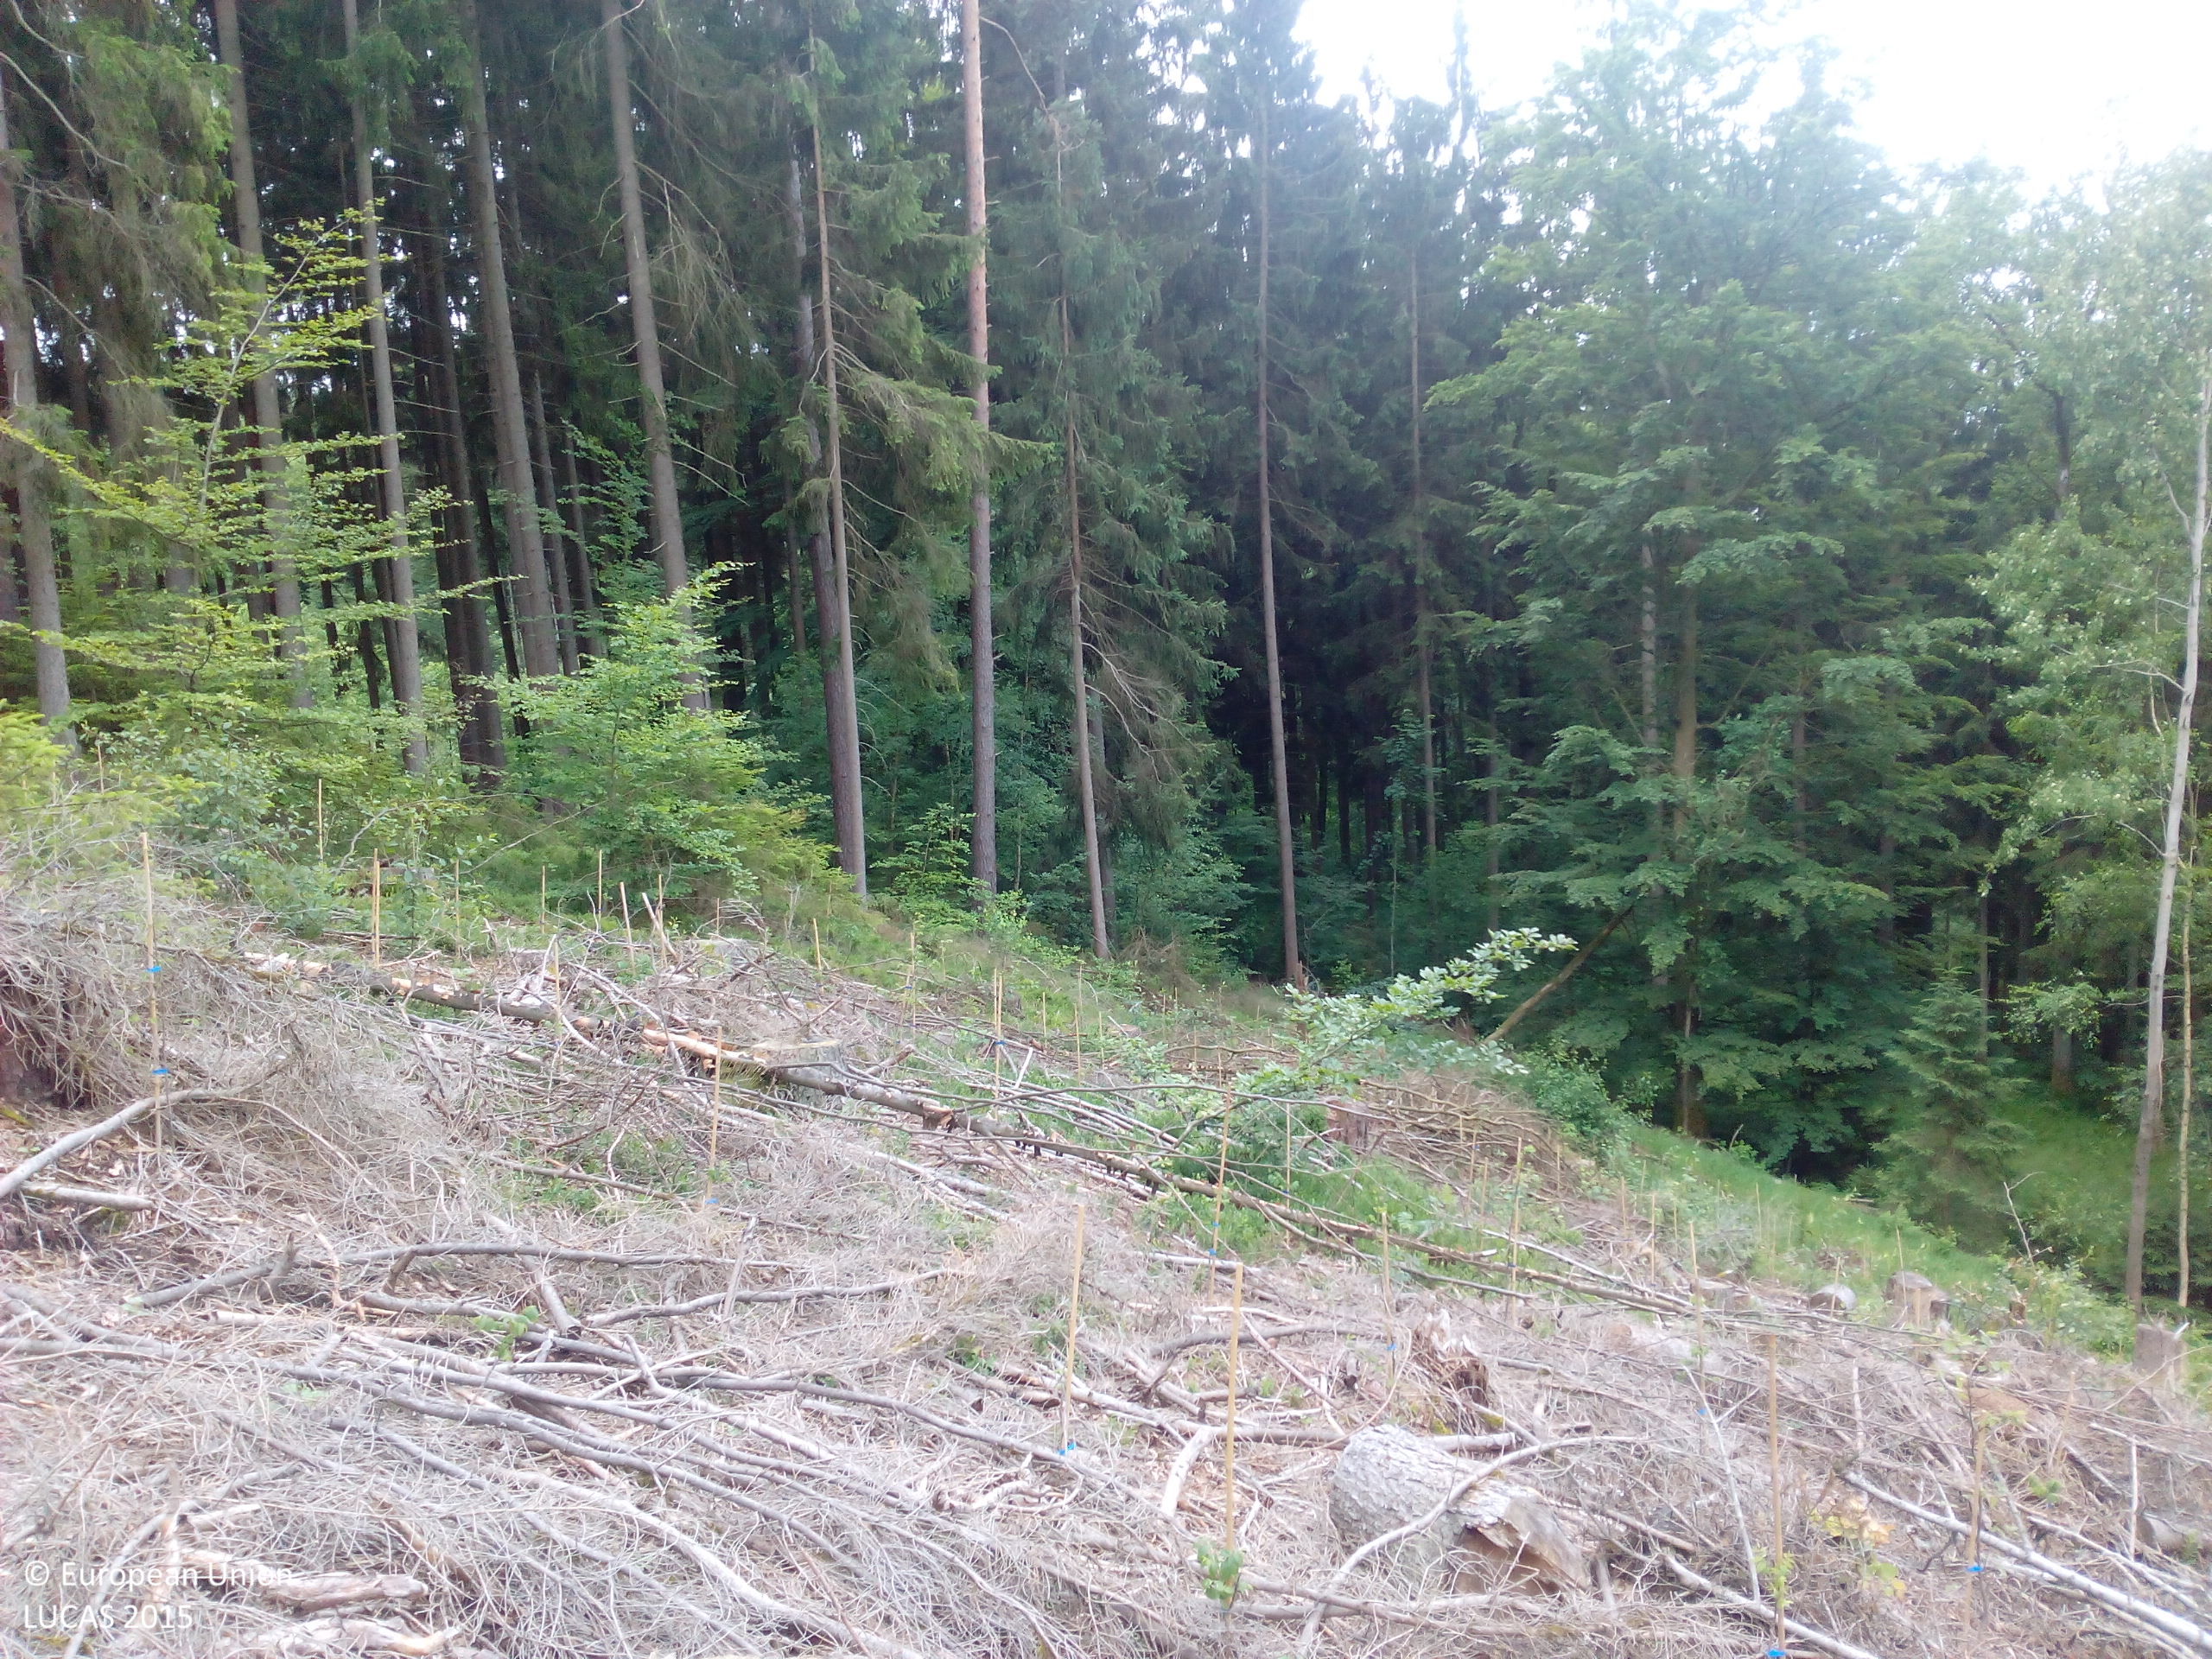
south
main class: Woodland
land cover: Broadleaved woodland
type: beech forest
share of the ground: 10 - 25 %
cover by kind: broadleaved forest trees 10 %, herbaceous plants 5 %, lichens and mosses 5 %
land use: Forestry
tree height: < 5 m
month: June
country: DE
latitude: 49.0070
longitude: 12.4191
